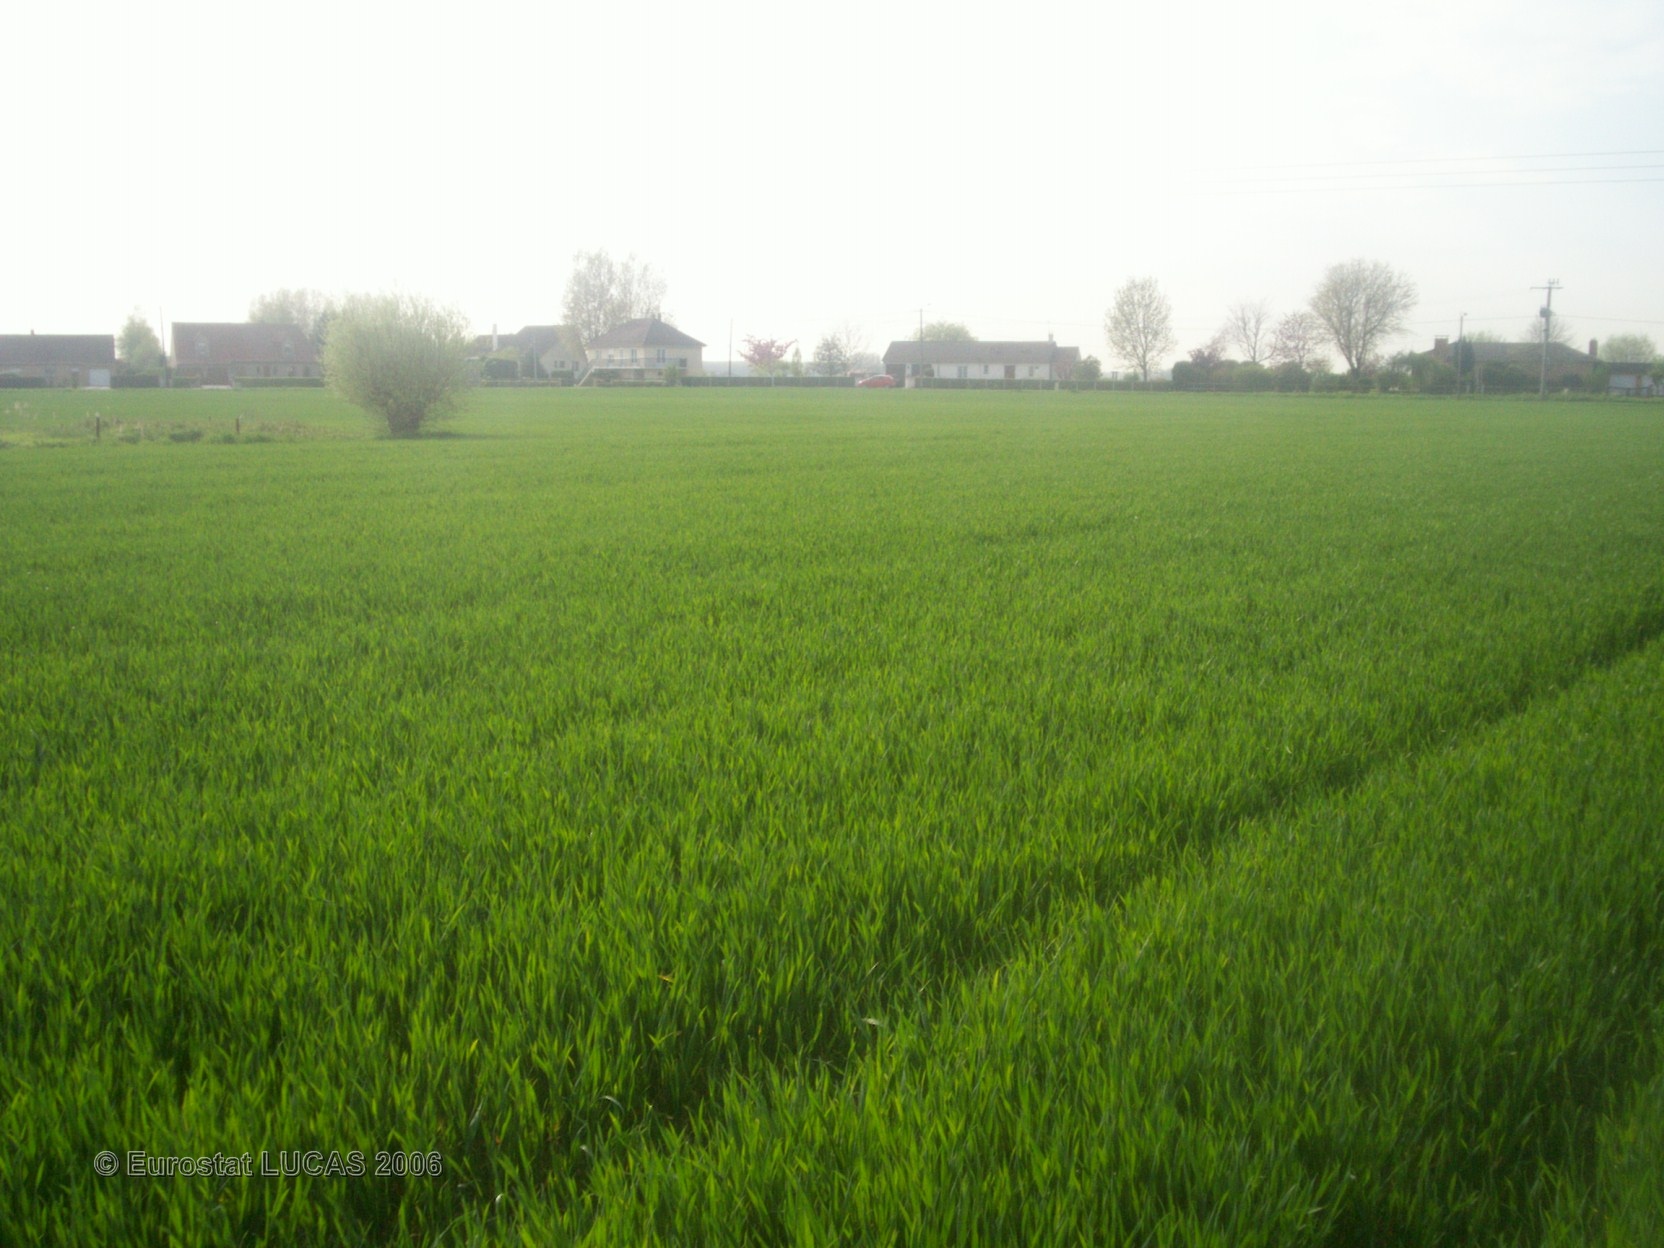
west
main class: Cropland
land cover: Common wheat
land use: Agriculture (excluding fallow land and kitchen gardens)
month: May
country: FR
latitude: 50.9813
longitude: 2.4519
